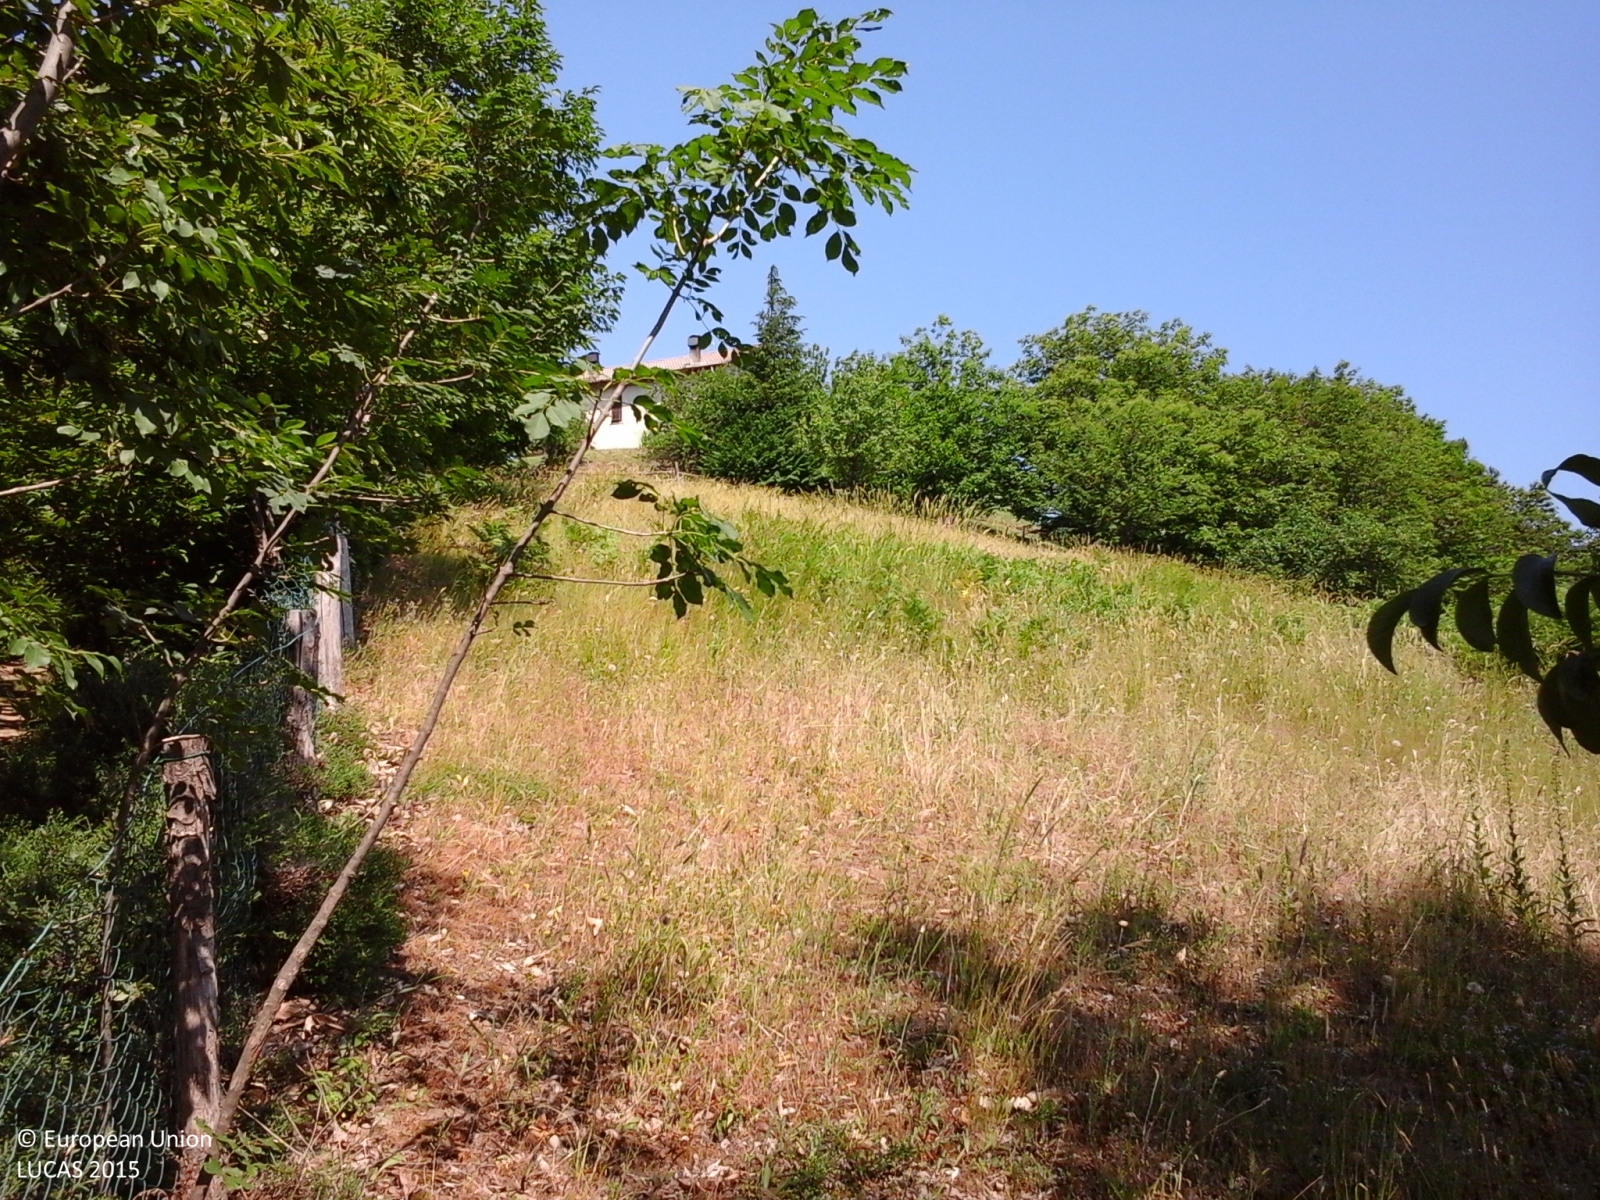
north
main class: Grassland
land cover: Grassland without tree/shrub cover
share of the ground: > 75 %
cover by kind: herbaceous plants 100 %
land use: Agriculture (excluding fallow land and kitchen gardens)
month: June
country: IT
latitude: 44.5944
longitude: 8.6550
